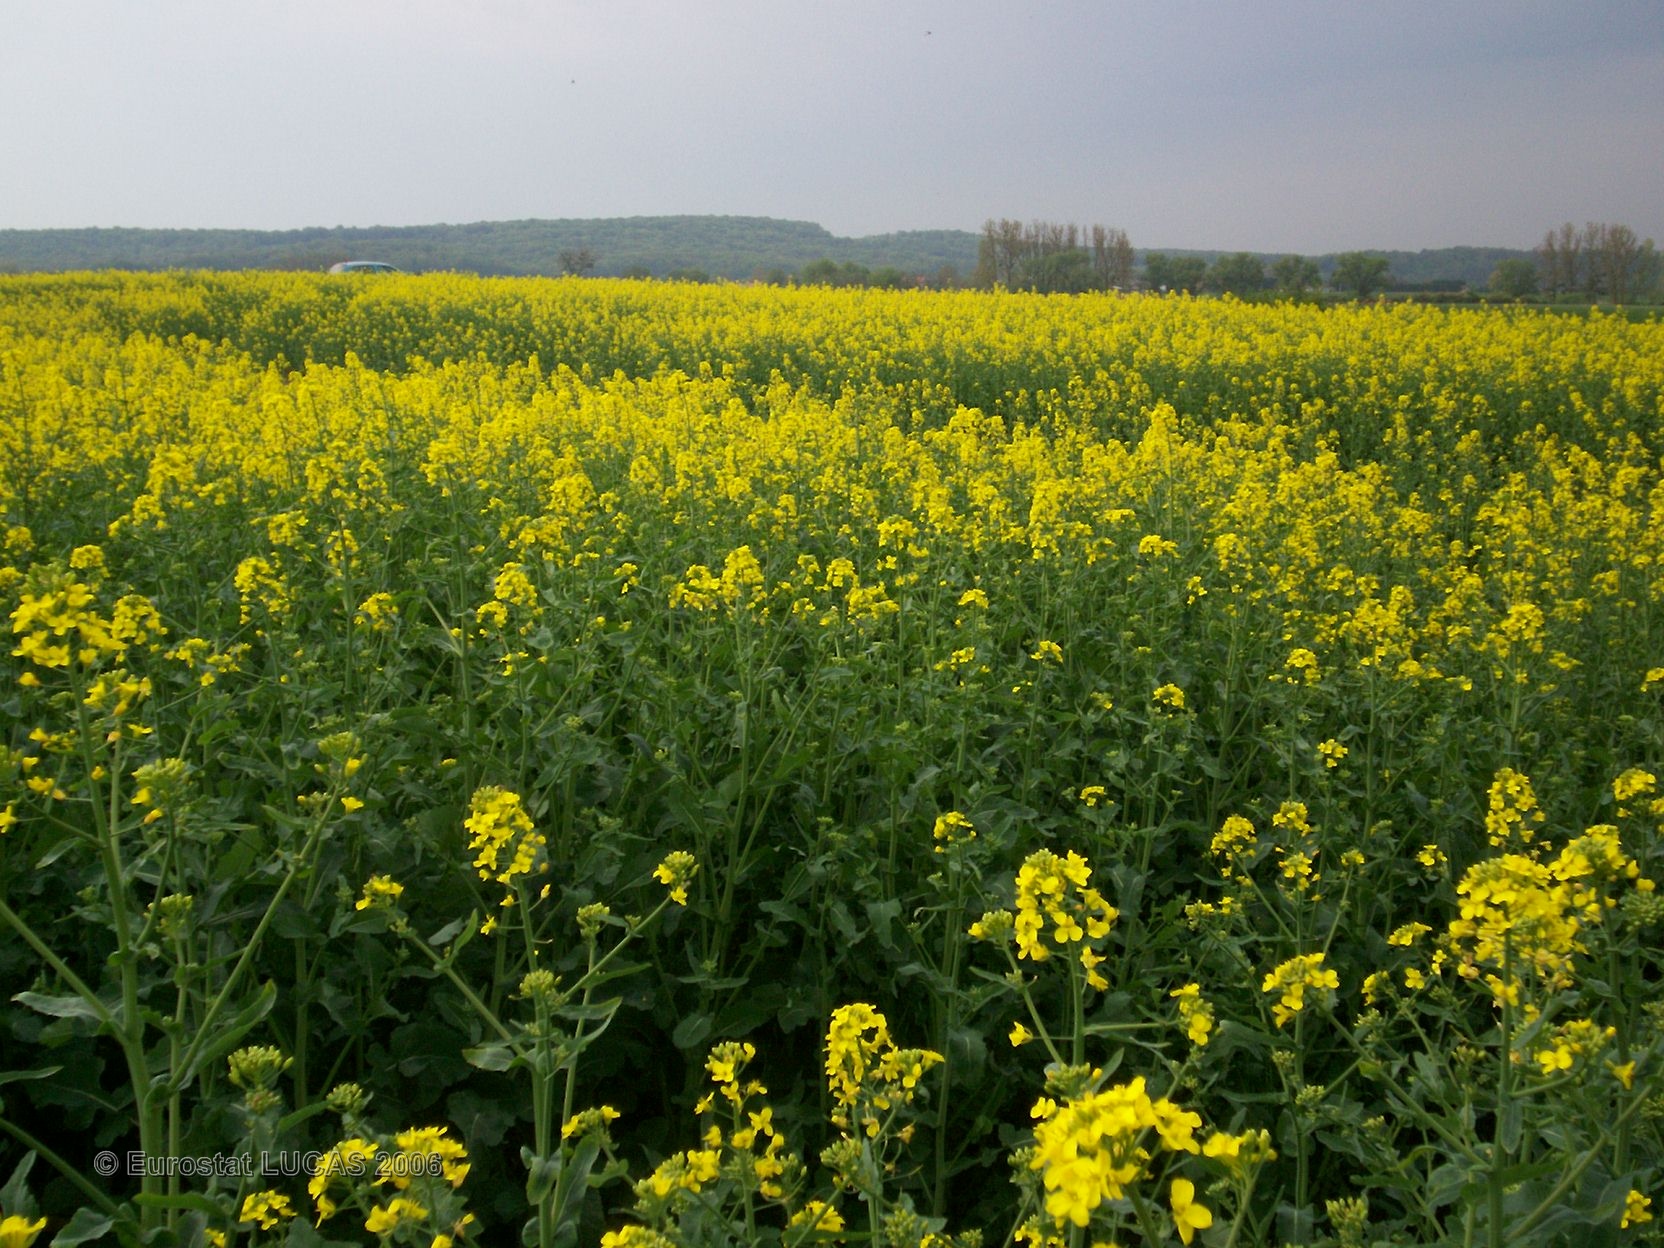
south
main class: Cropland
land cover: Rape and turnip rape
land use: Agriculture (excluding fallow land and kitchen gardens)
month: May
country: FR
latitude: 49.1560
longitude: 6.4212
